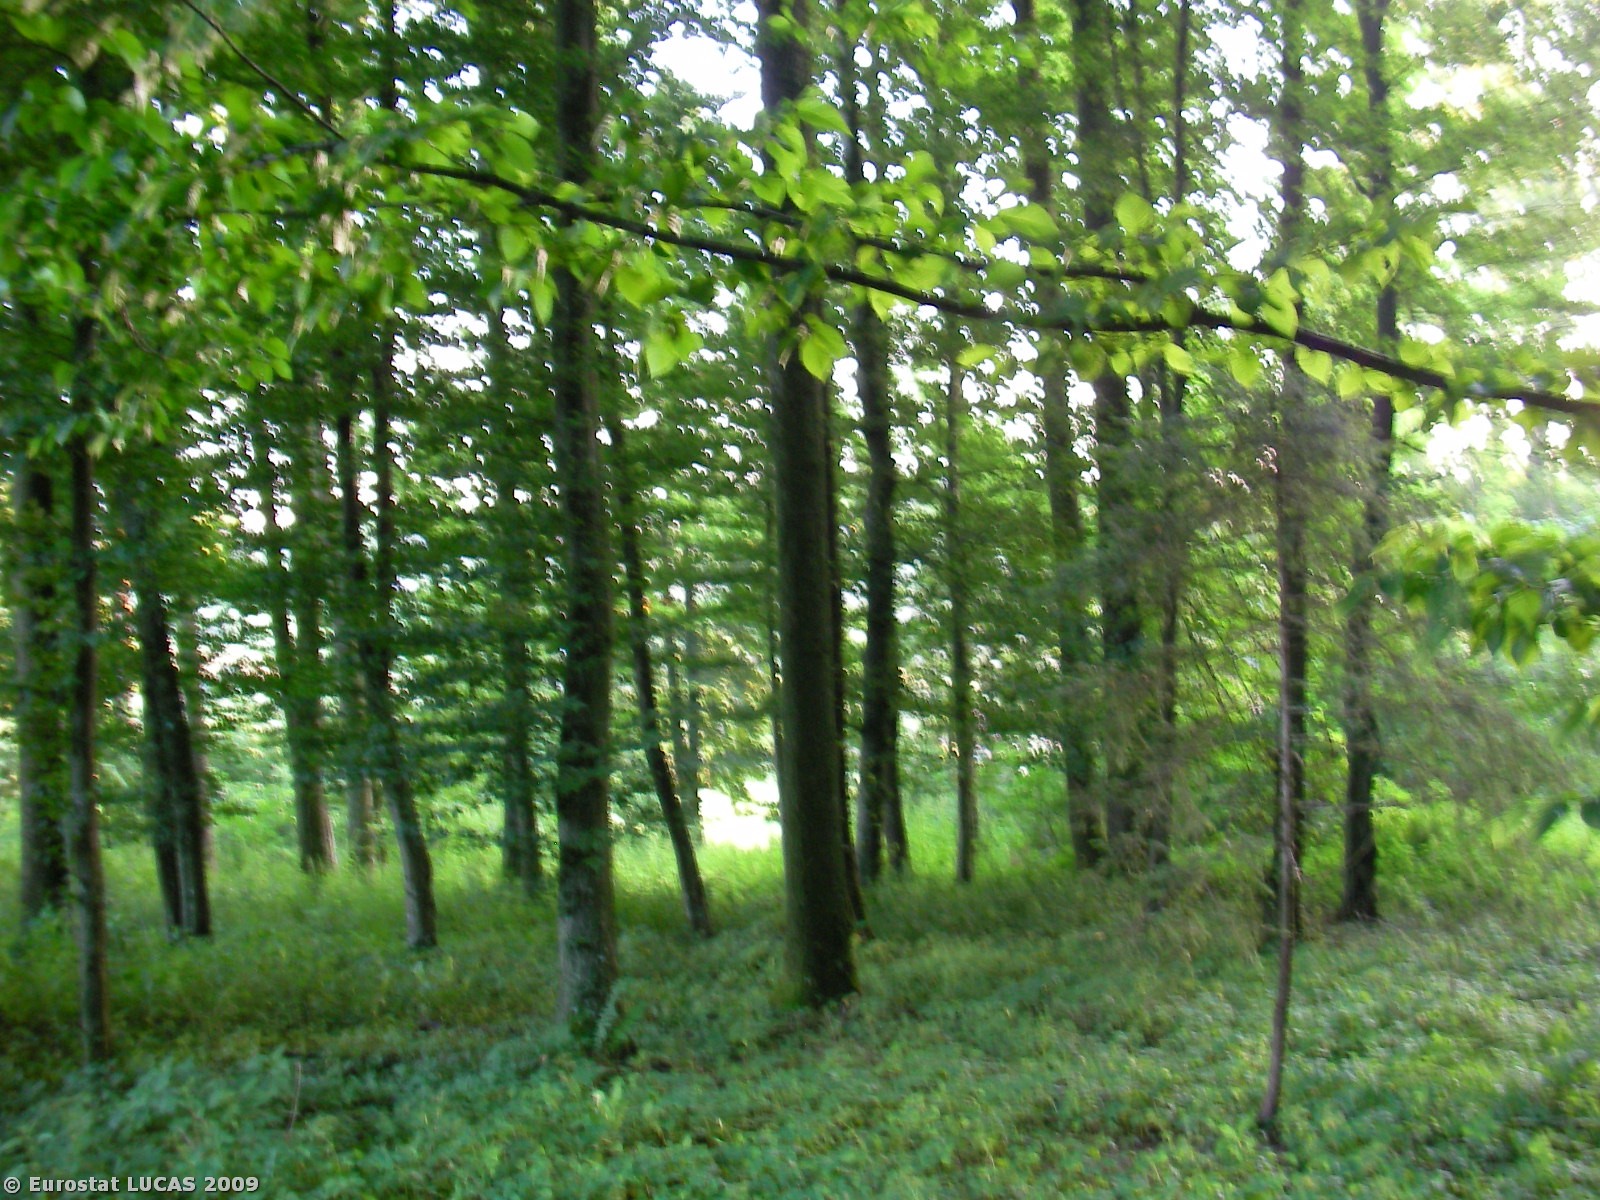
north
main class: Woodland
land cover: Broadleaved woodland
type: beech forest
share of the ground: > 75 %
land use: Forestry
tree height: > 5 m
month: July
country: AT
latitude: 46.9745
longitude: 15.7183
